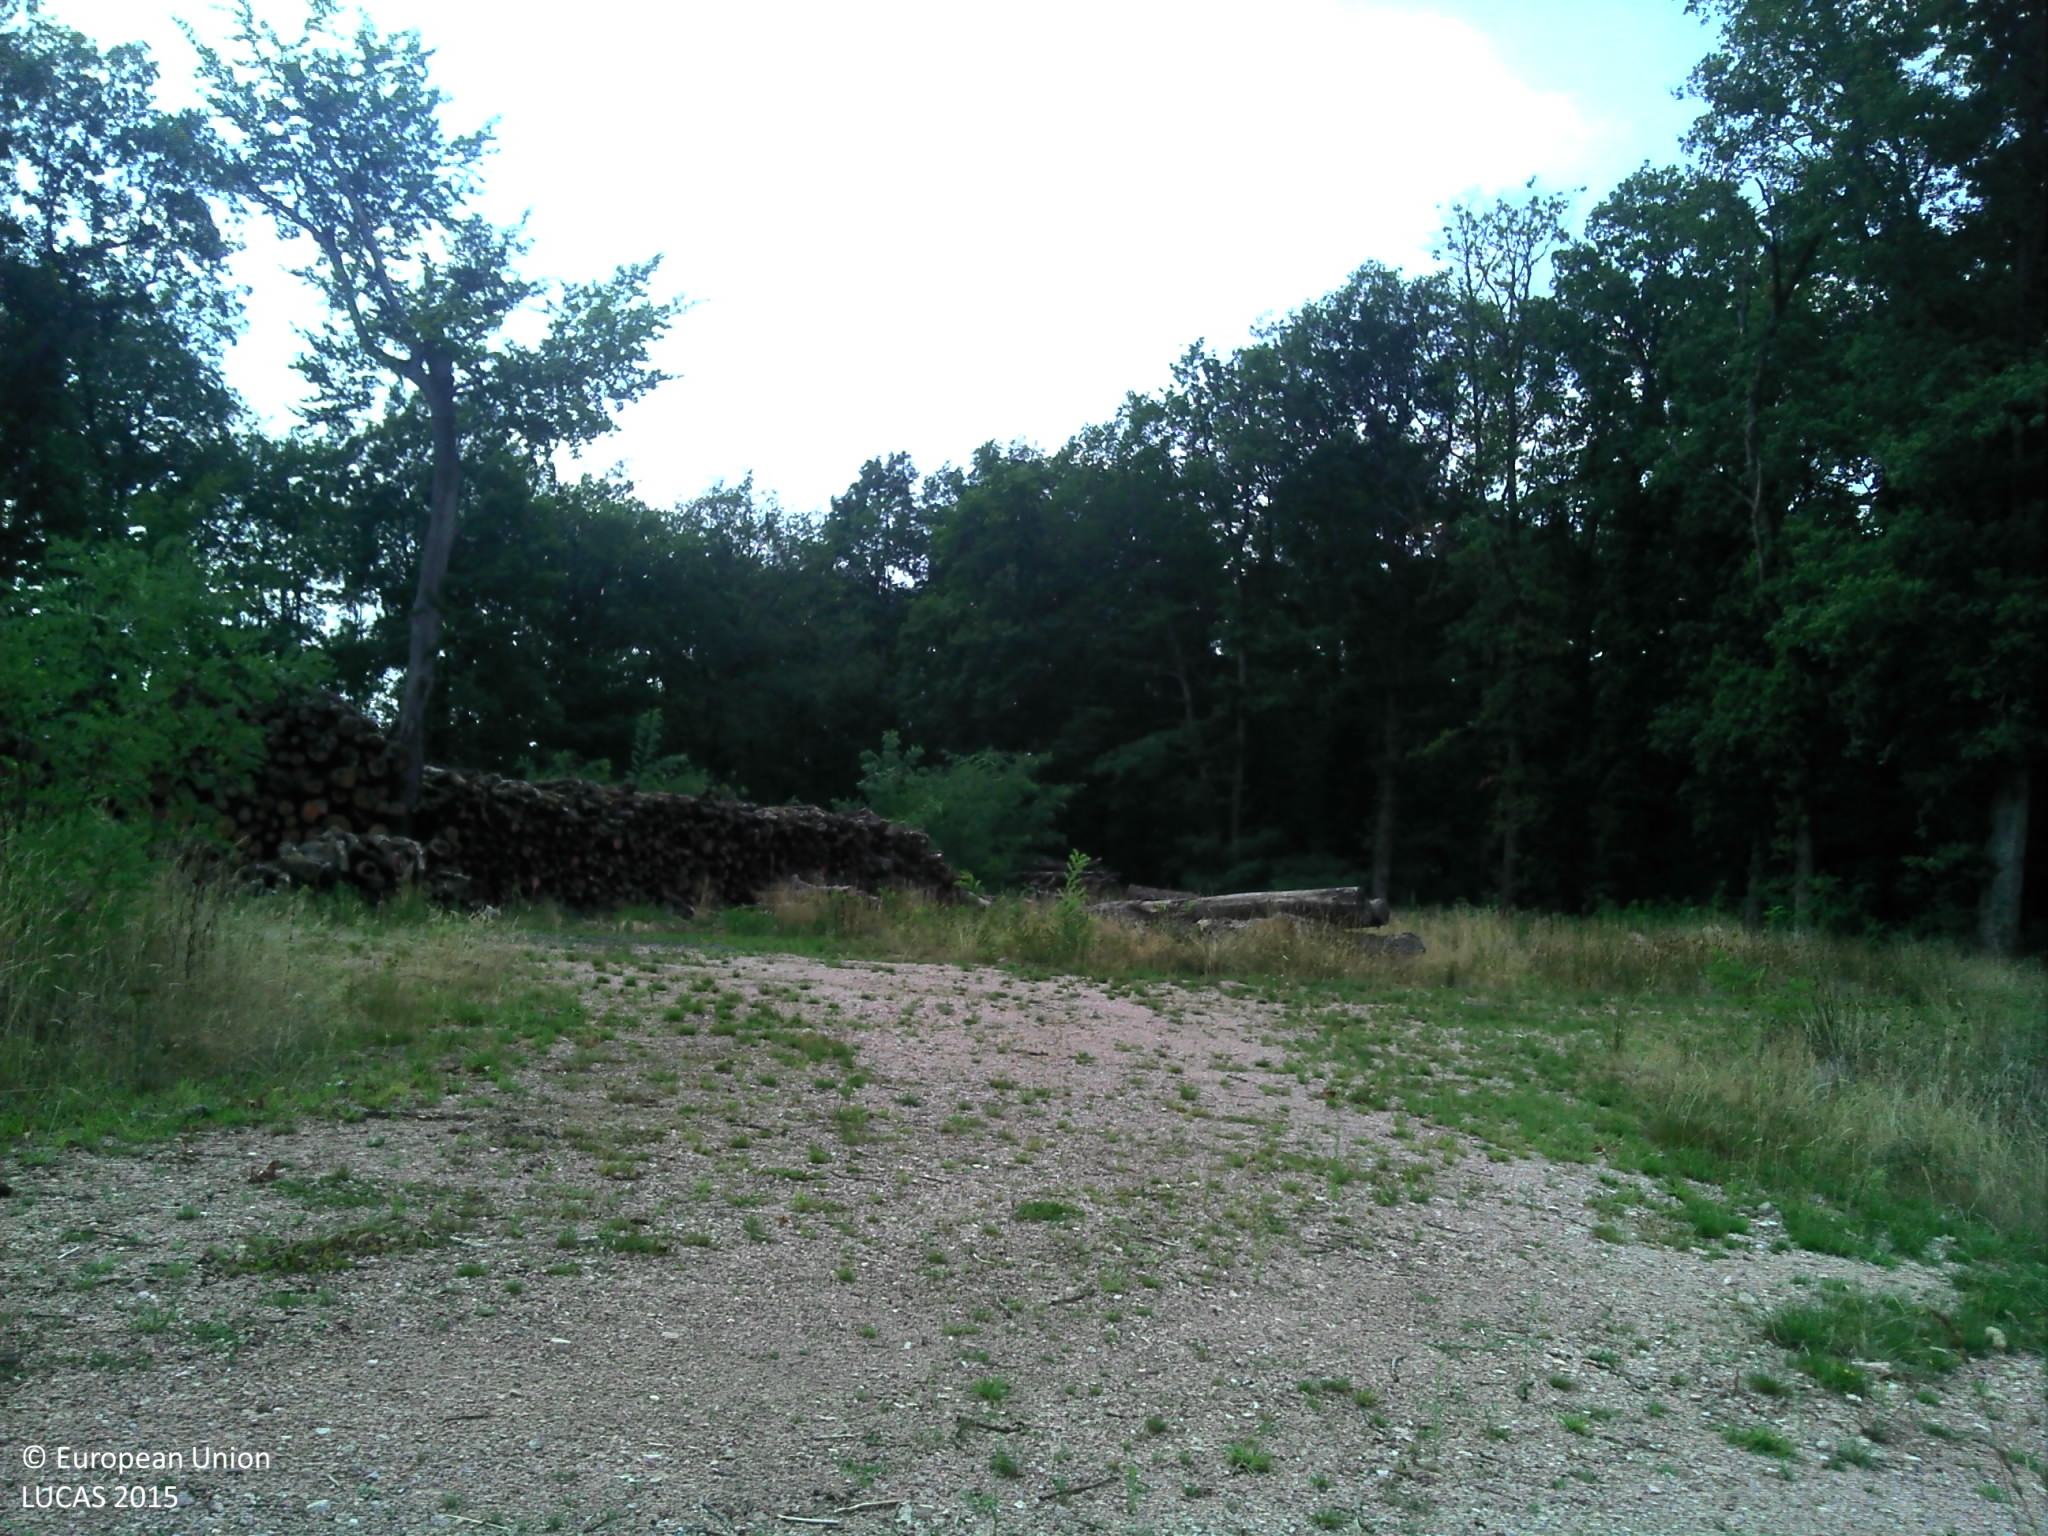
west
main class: Grassland
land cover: Grassland without tree/shrub cover
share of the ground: > 75 %
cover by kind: herbaceous plants 100 %
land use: Agriculture (excluding fallow land and kitchen gardens)
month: August
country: FR
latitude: 46.3445
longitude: 3.6721
